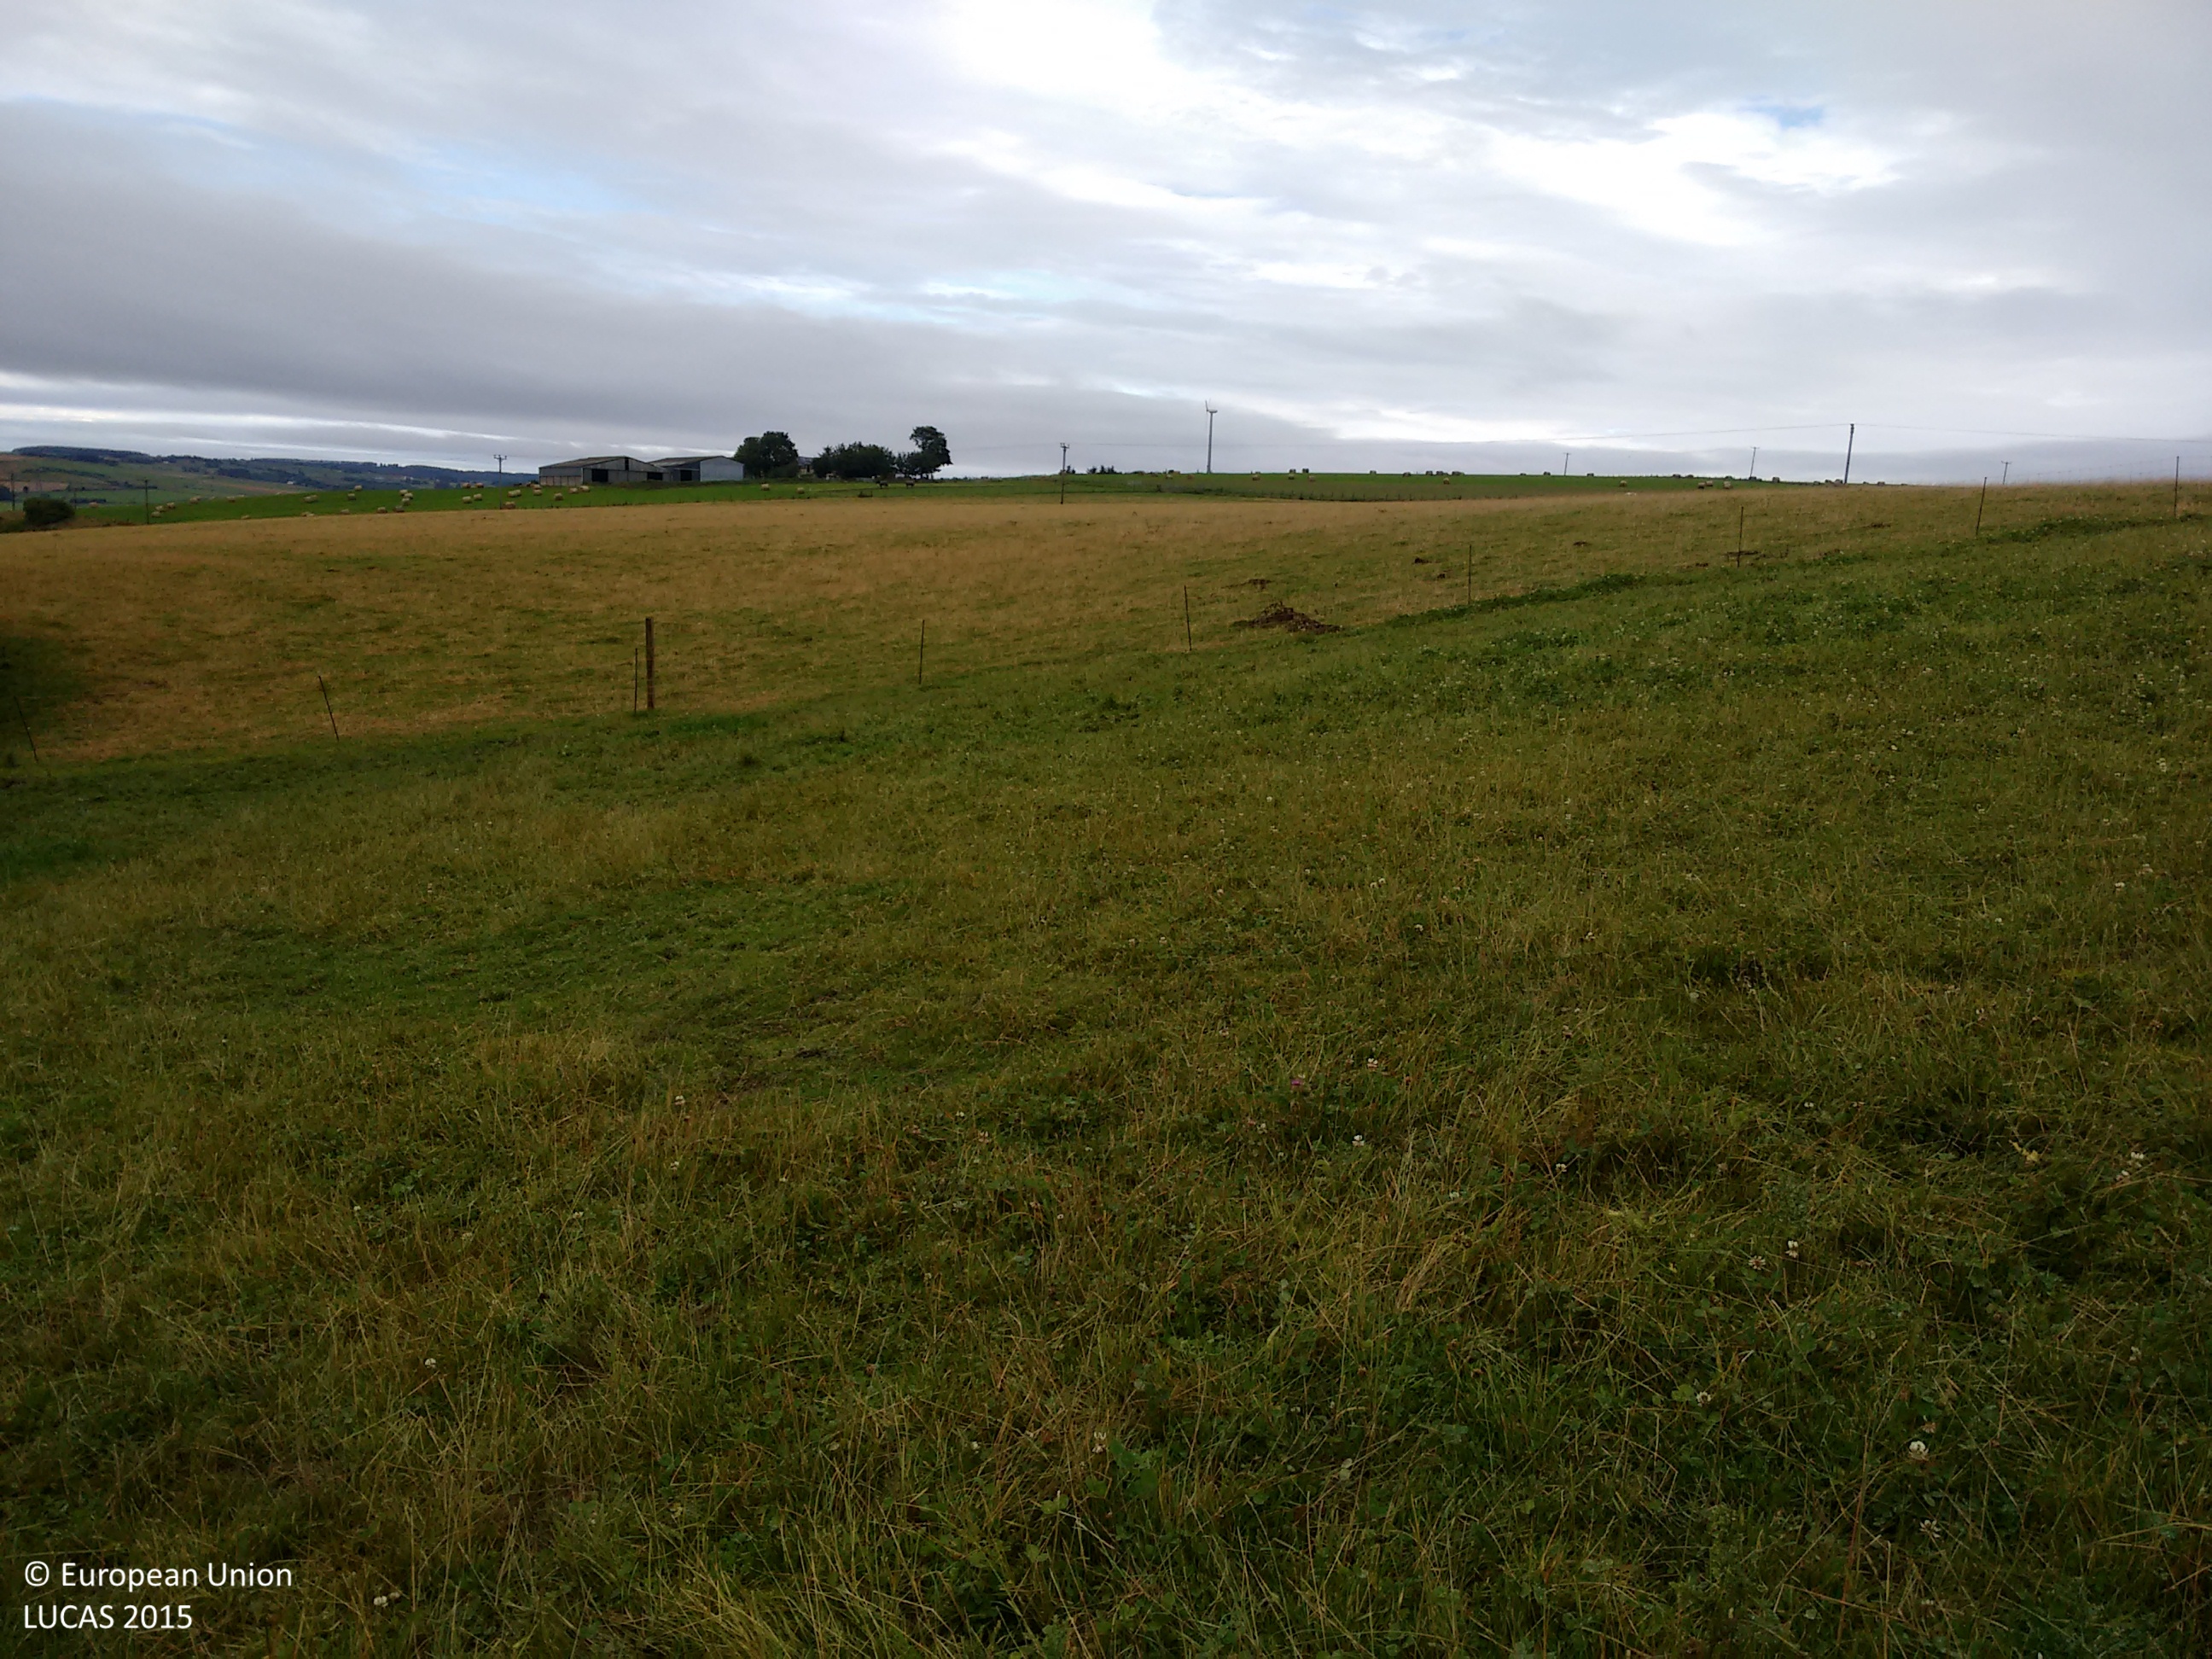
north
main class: Grassland
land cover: Grassland without tree/shrub cover
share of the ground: > 75 %
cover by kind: herbaceous plants 95 %, unconsolidated bare surface 5 %
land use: Agriculture (excluding fallow land and kitchen gardens)
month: September
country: GB
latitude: 57.5391
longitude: -2.9055
